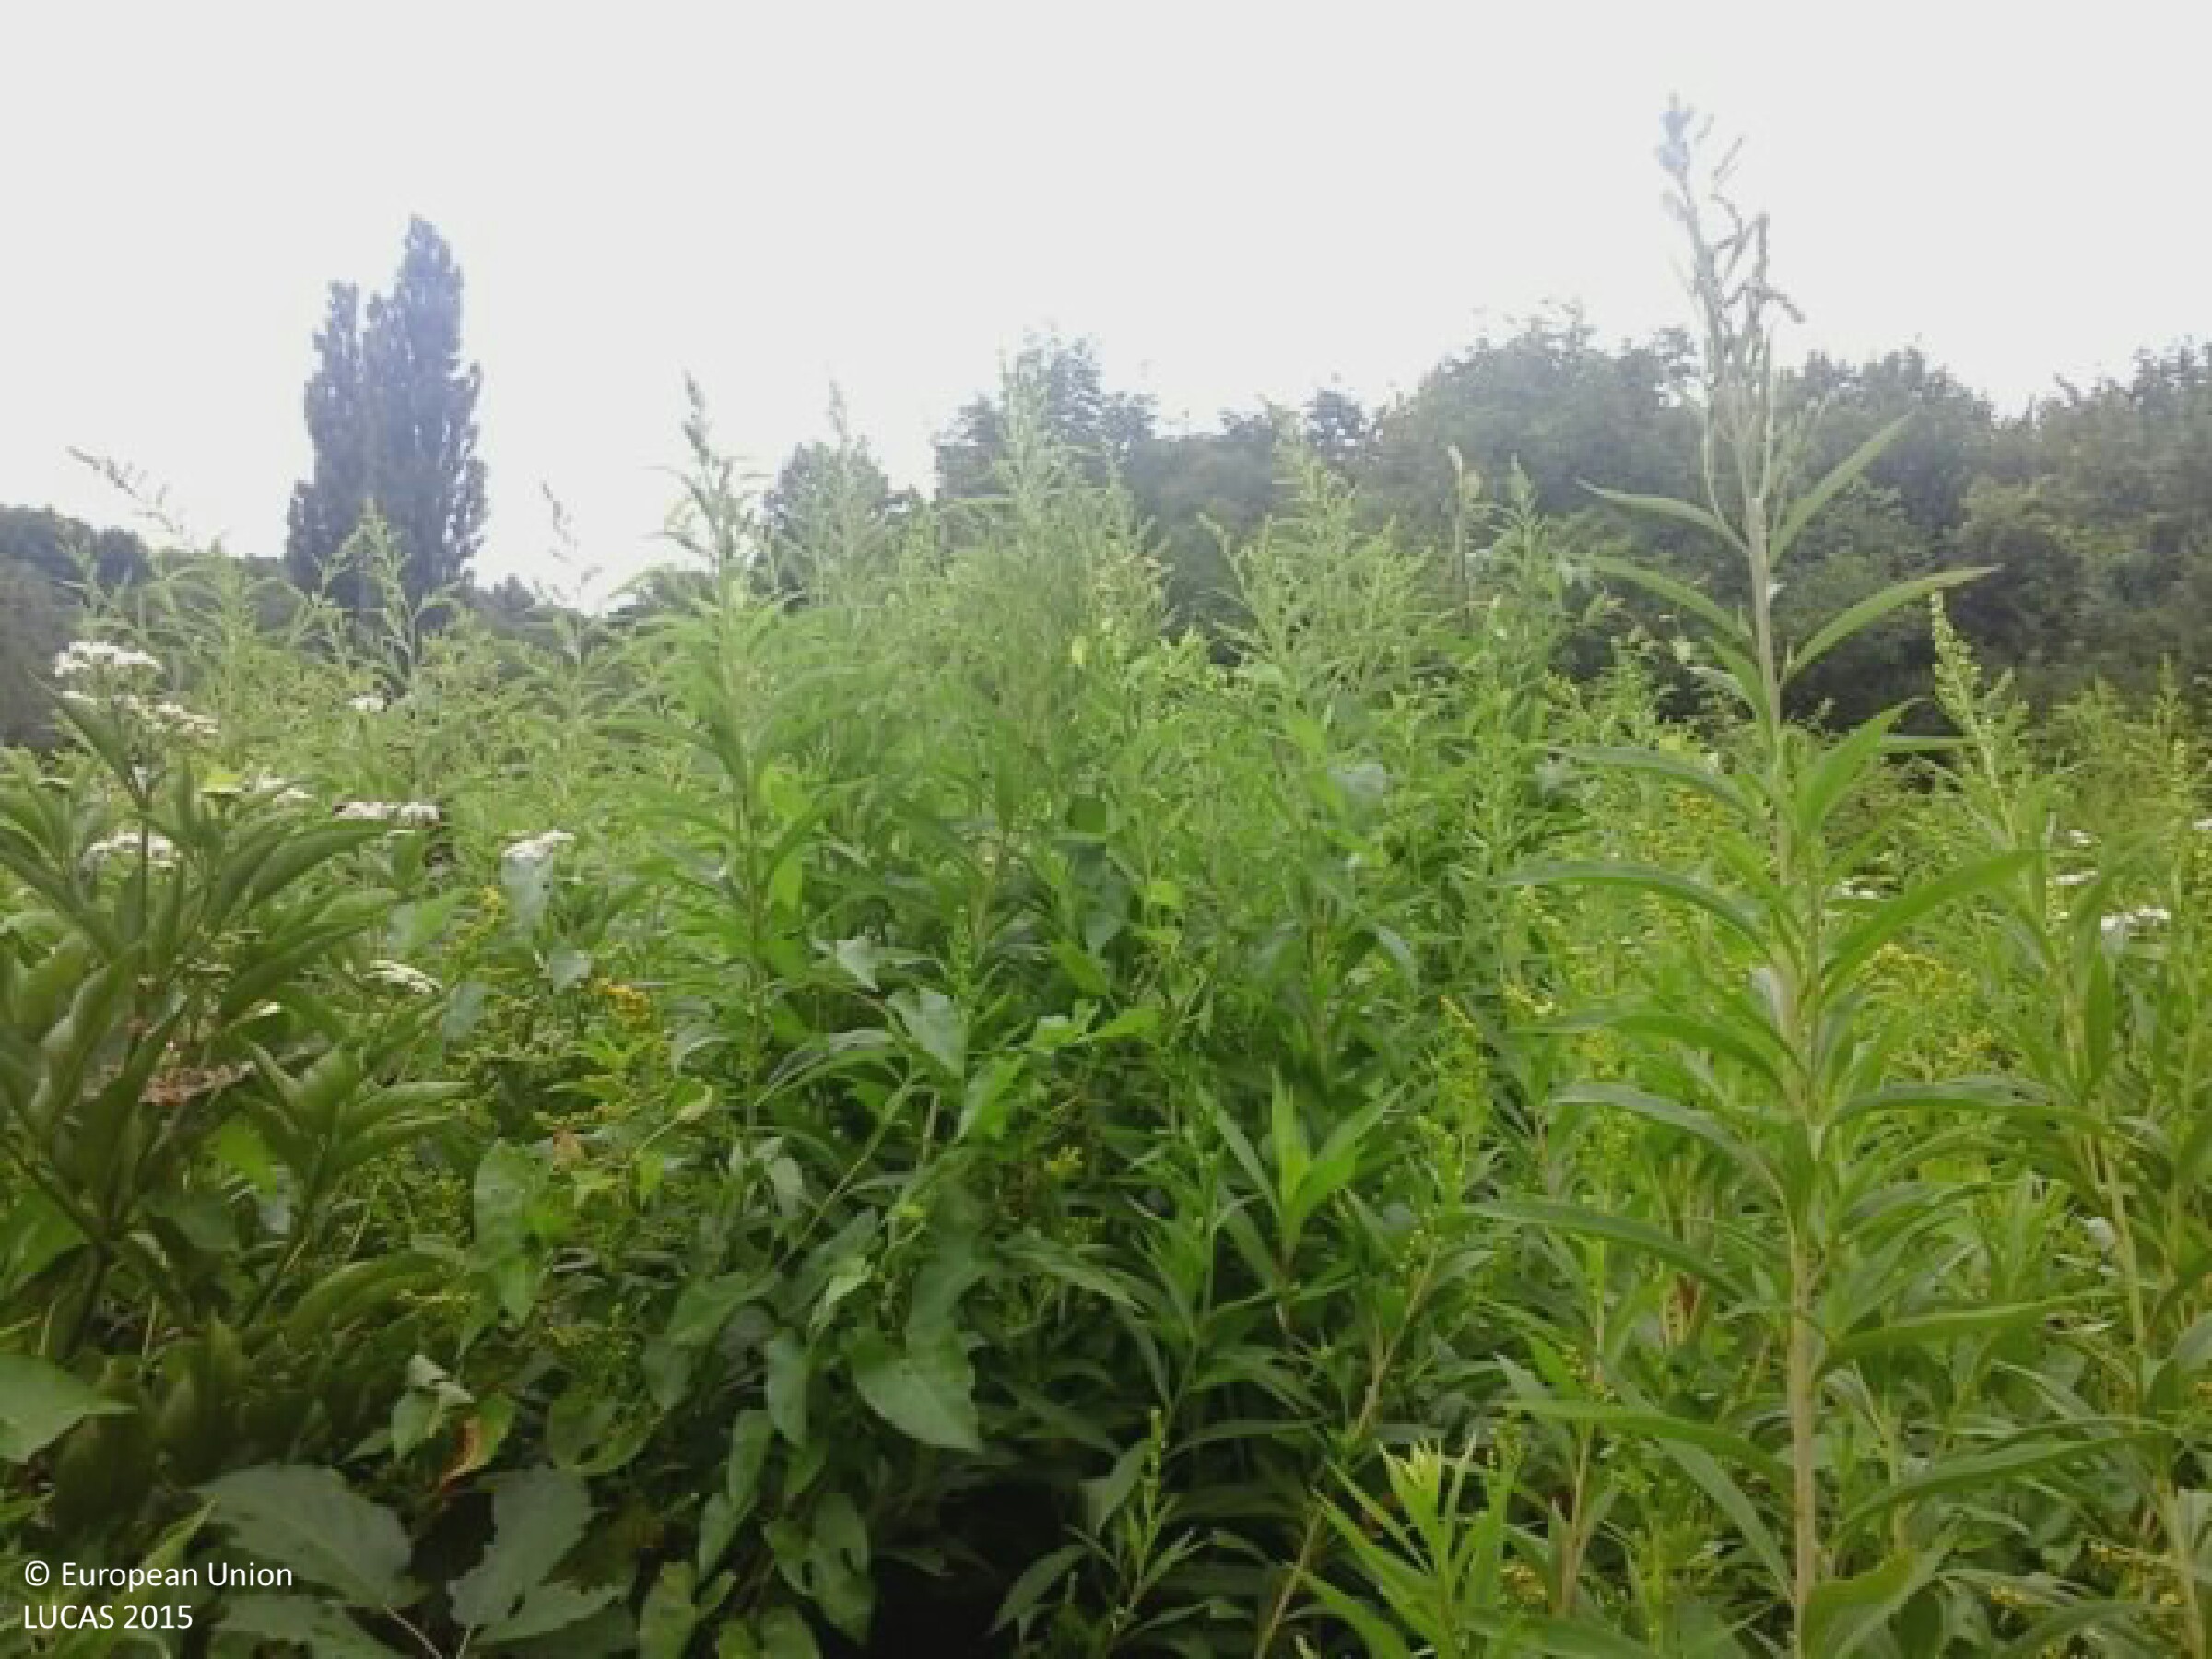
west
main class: Grassland
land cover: Spontaneously vegetated surfaces
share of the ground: > 75 %
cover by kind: herbaceous plants 95 %, shrubs 5 %
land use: Fallow land
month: August
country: HU
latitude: 46.2496
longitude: 18.0096
